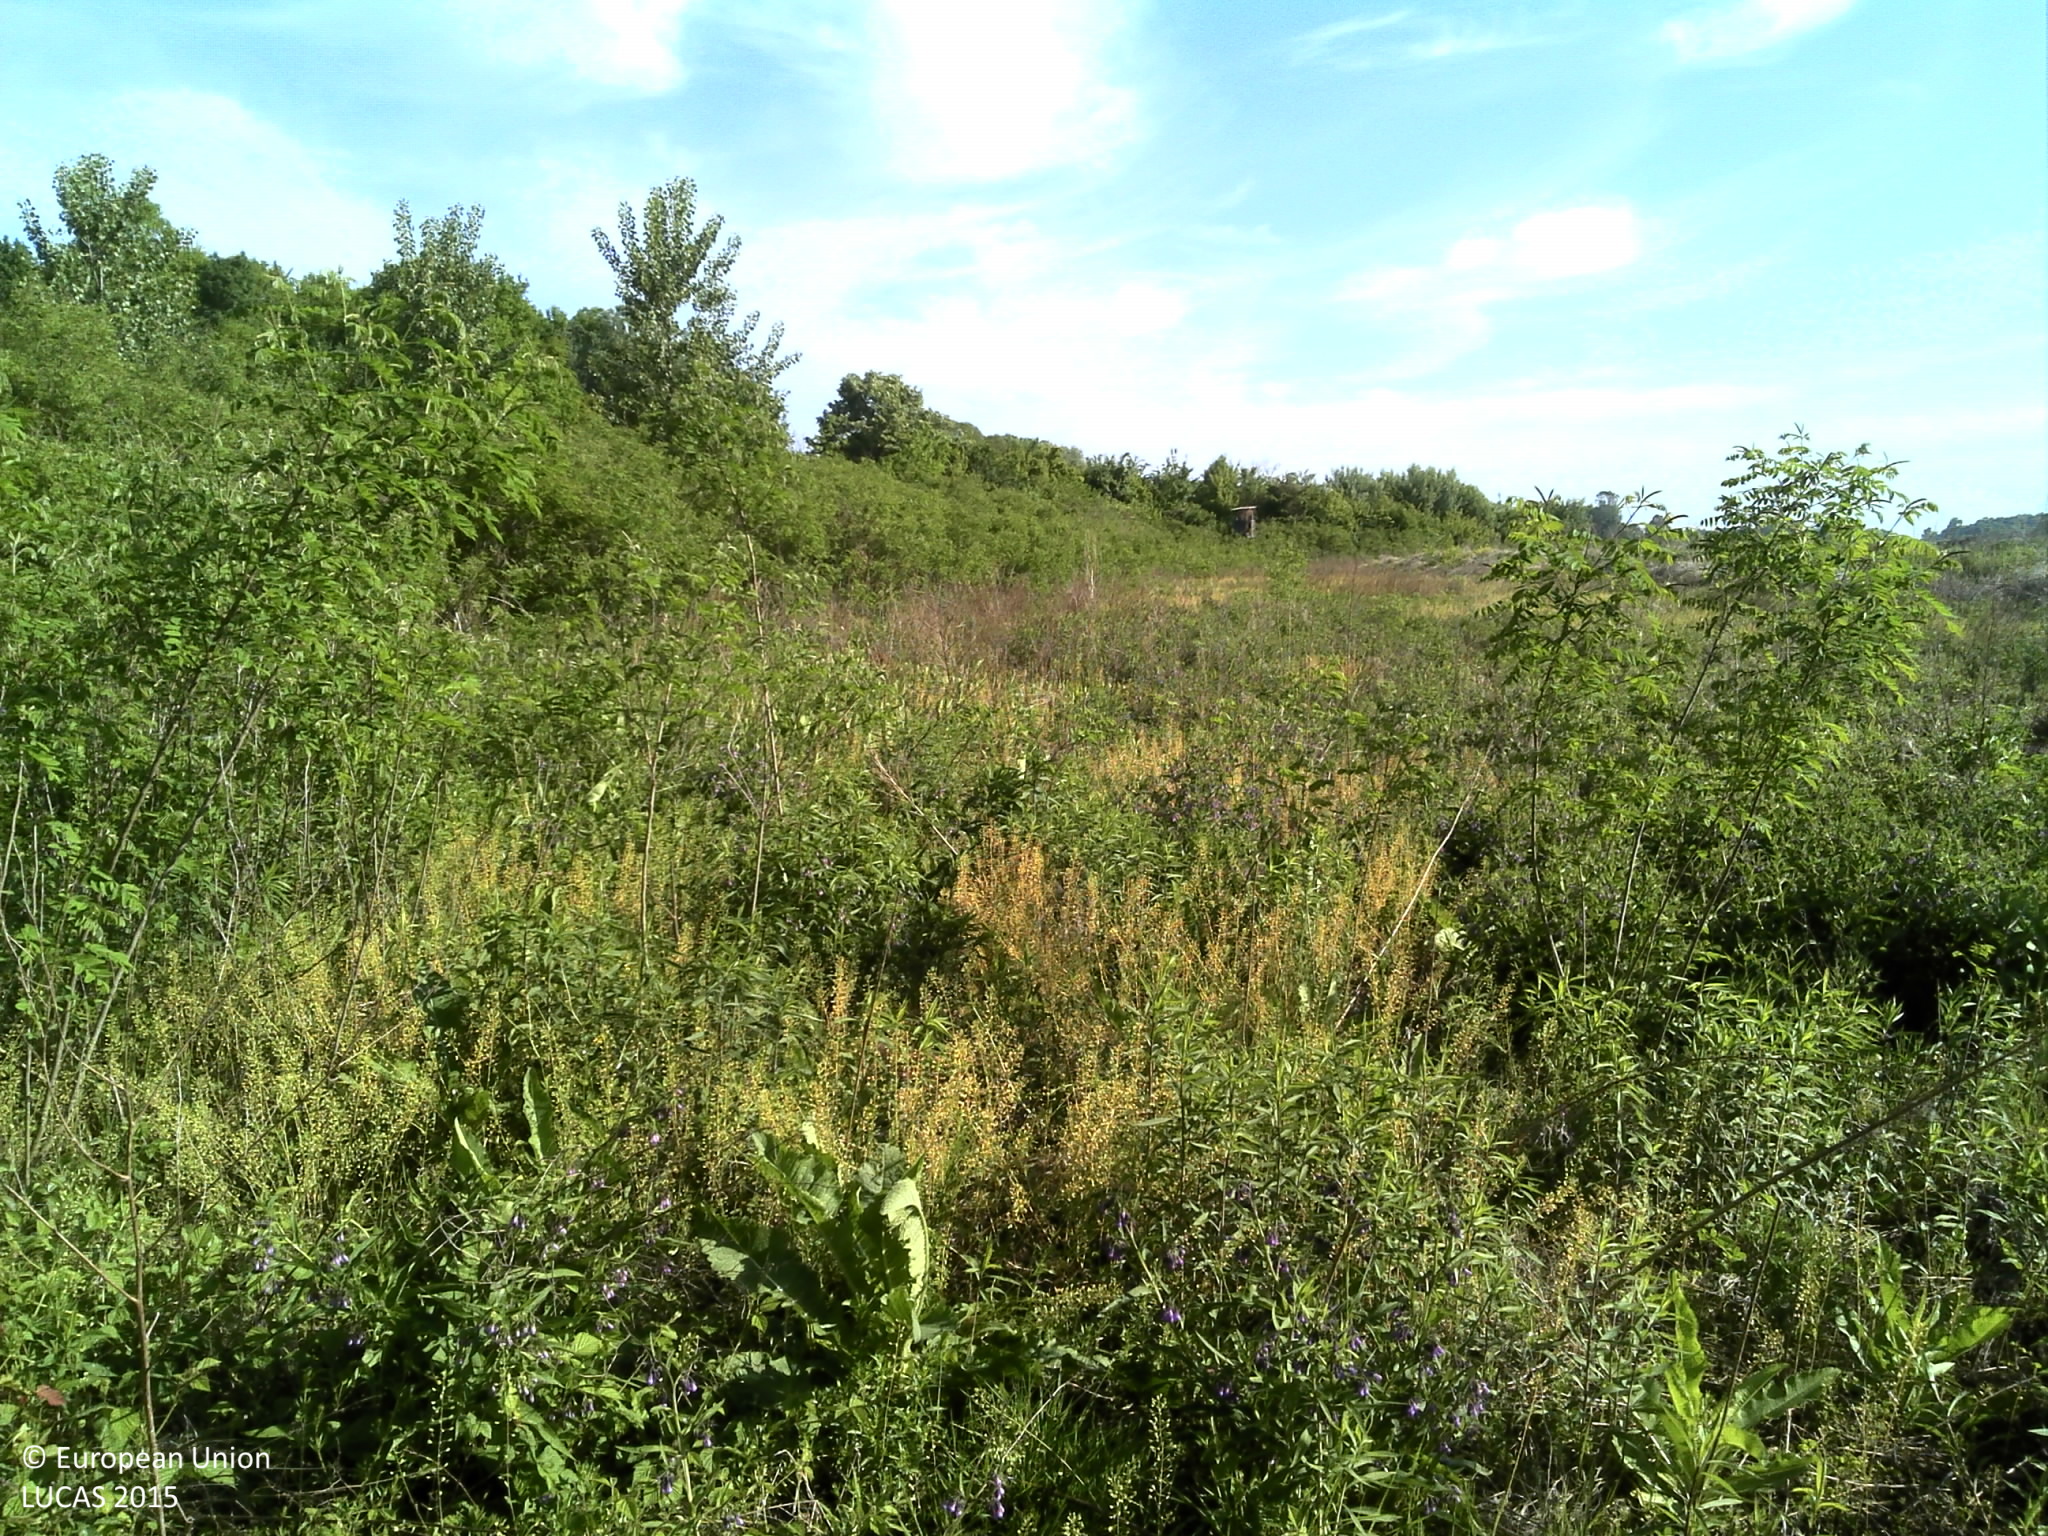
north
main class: Shrubland
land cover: Shrubland with sparse tree cover
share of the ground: > 75 %
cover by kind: shrubs 90 %, broadleaved forest trees 5 %, herbaceous plants 5 %
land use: Semi-natural and natural areas not in use
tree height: > 5 m
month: May
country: HR
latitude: 45.1302
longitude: 18.4342
